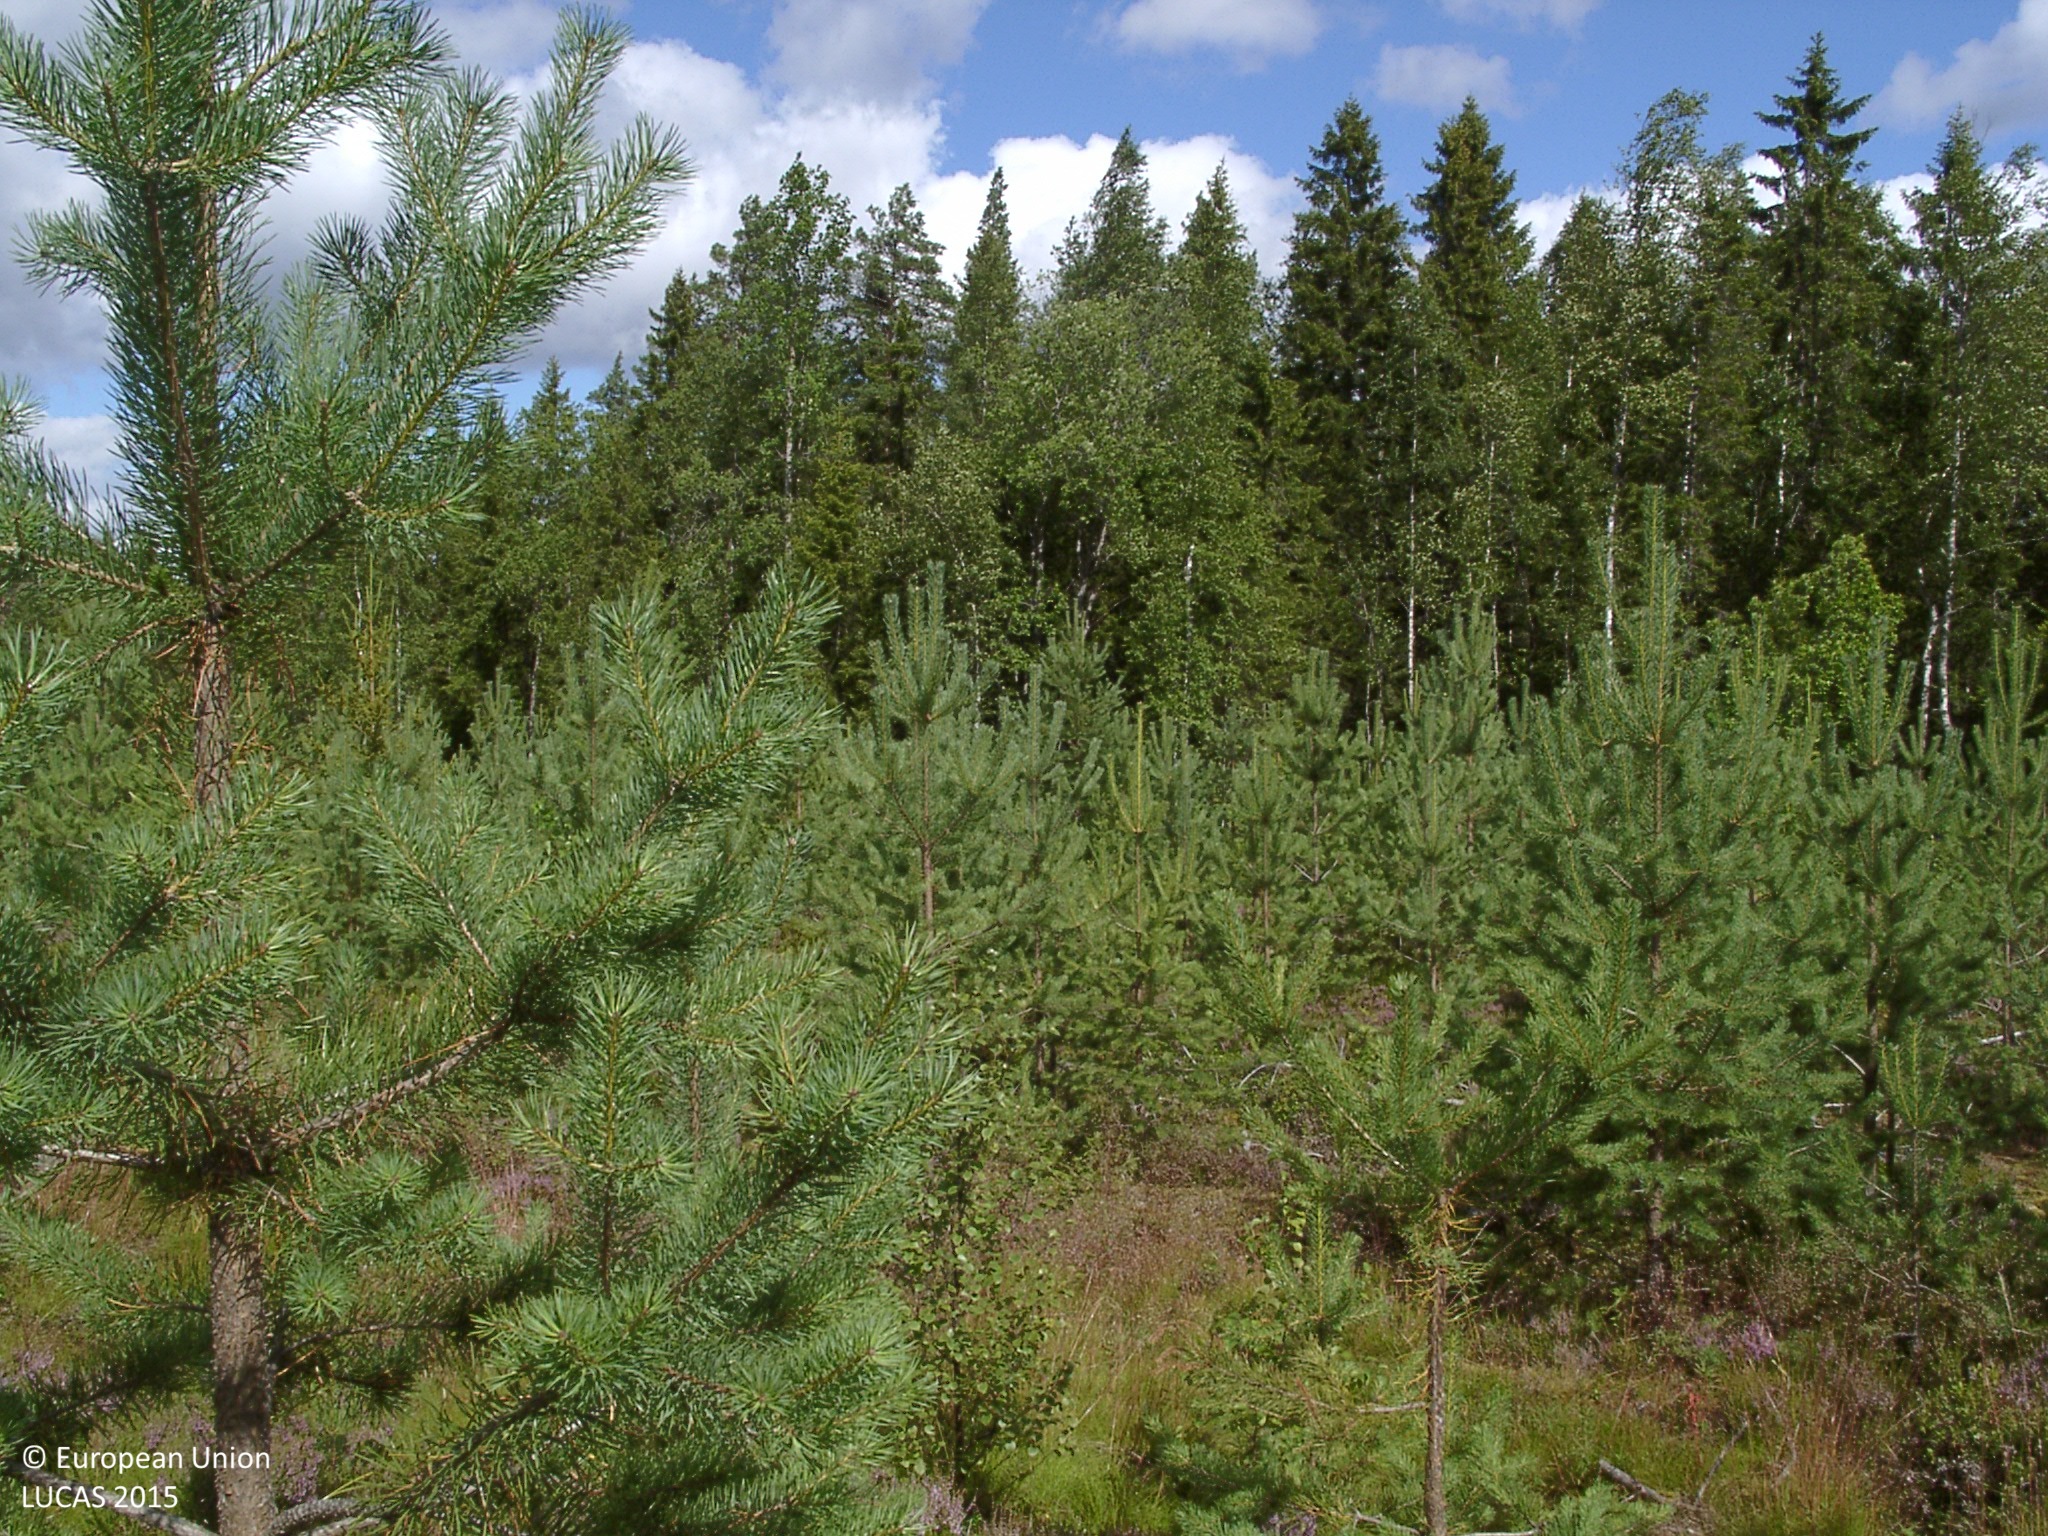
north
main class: Woodland
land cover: Pine dominated coniferous woodland
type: boreal forest
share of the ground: 25 - 50 %
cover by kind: coniferous forest trees 40 %, shrubs 35 %, lichens and mosses 15 %, broadleaved forest trees 5 %, herbaceous plants 5 %
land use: Forestry
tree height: < 5 m
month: August
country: FI
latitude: 62.9996
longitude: 24.5983
